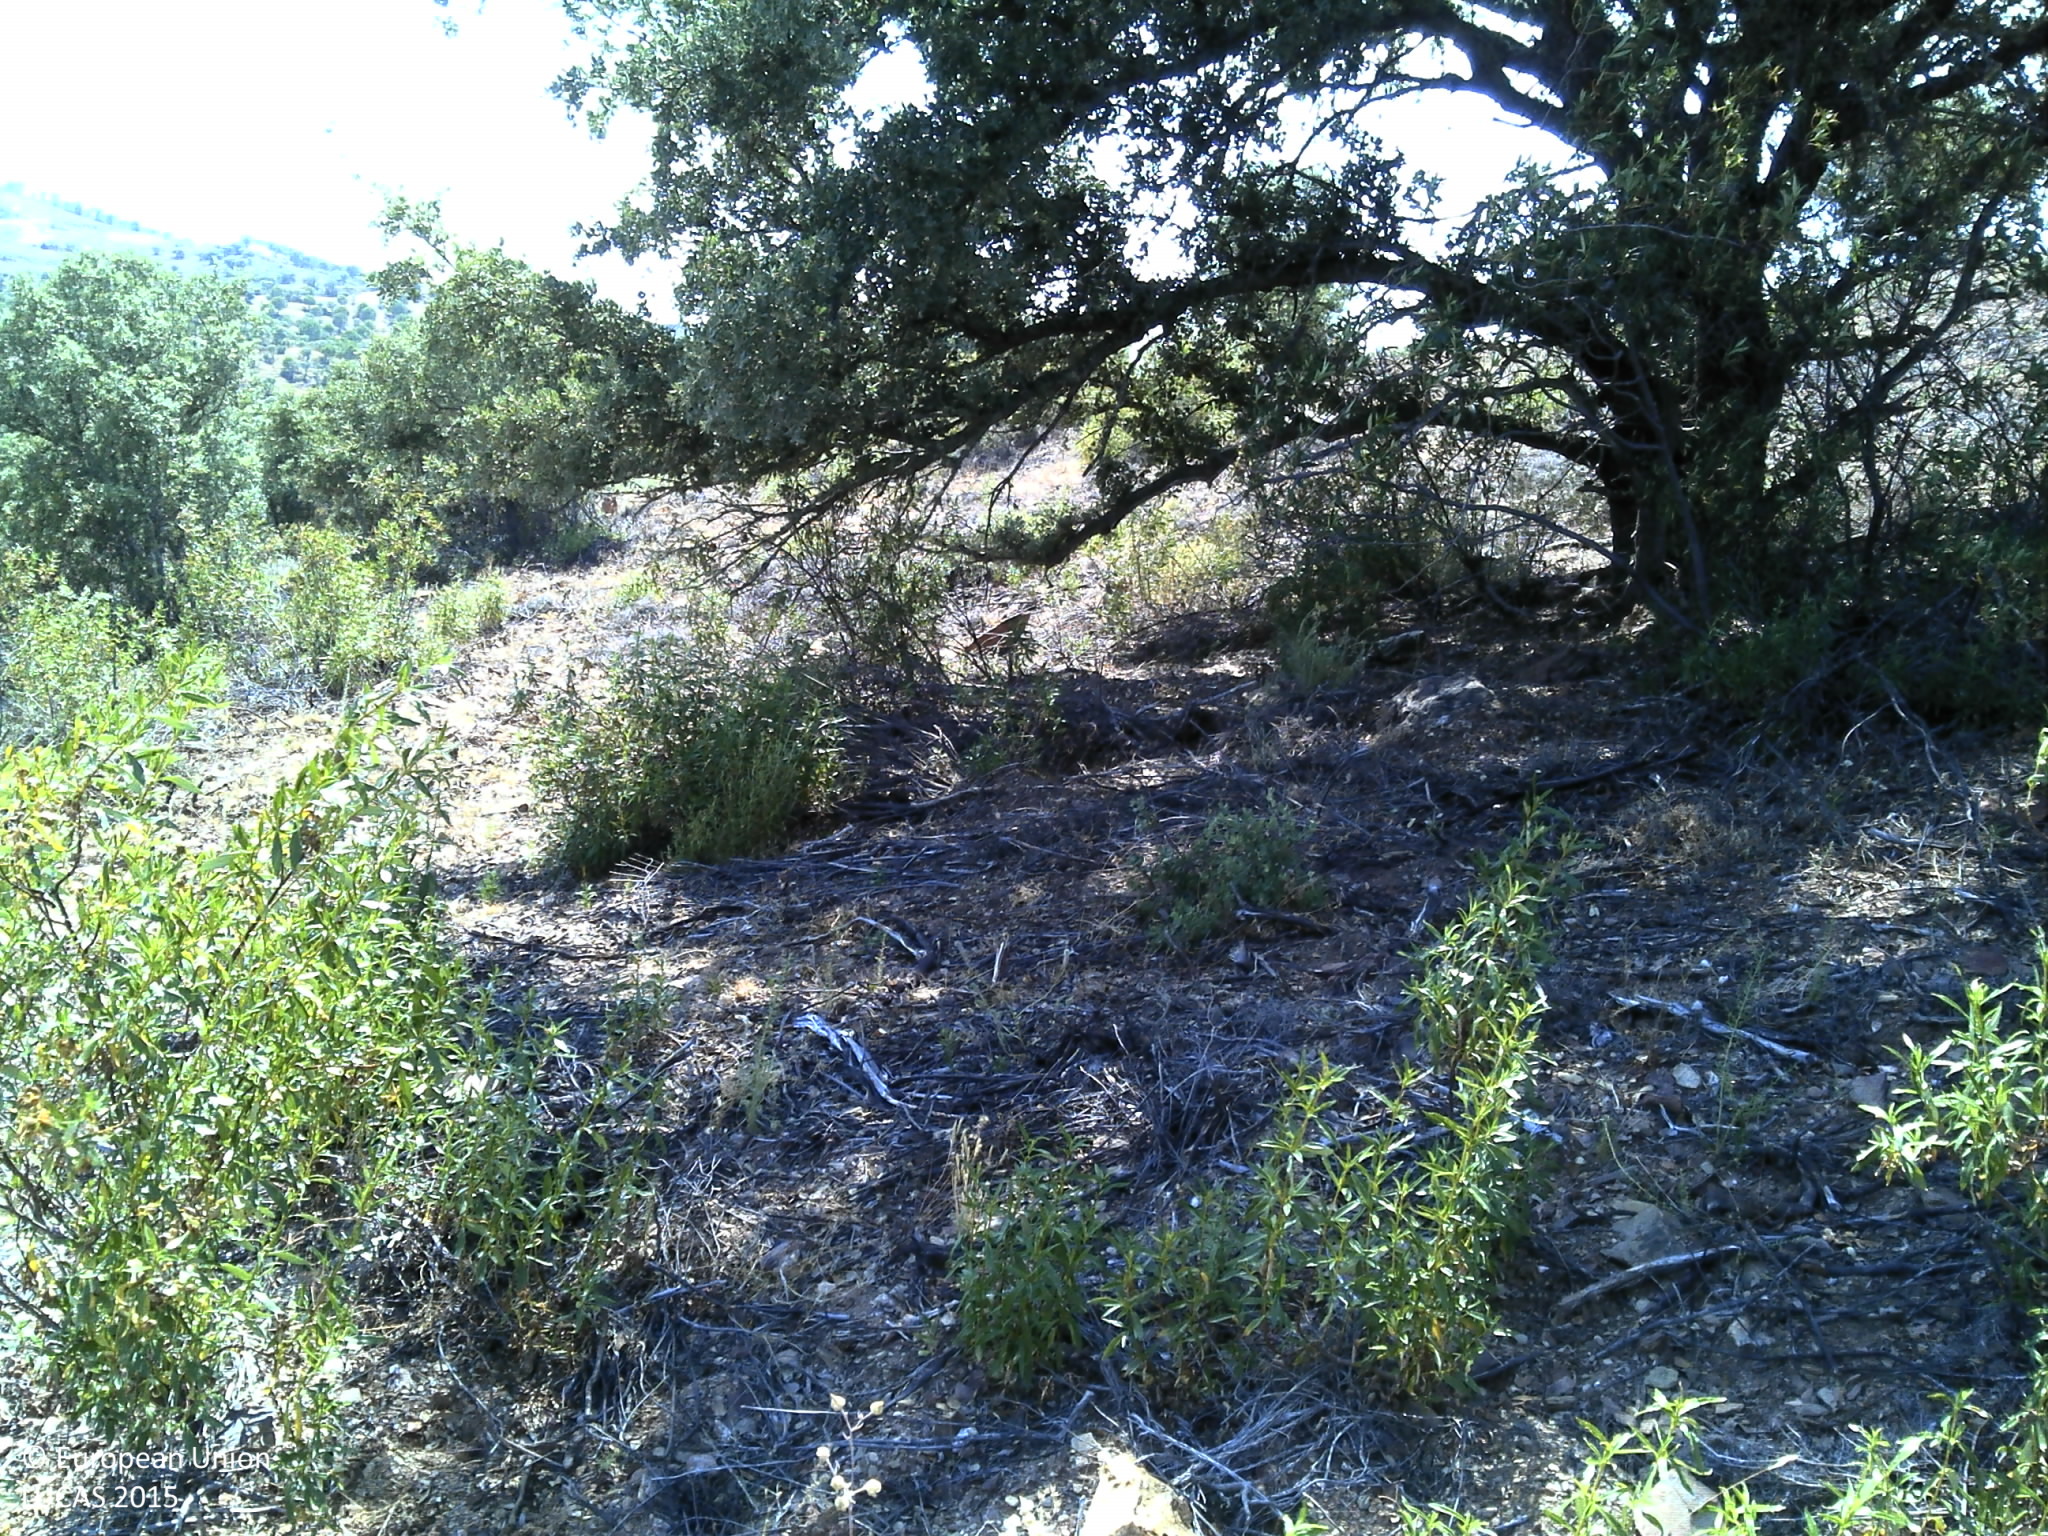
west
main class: Shrubland
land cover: Shrubland with sparse tree cover
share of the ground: 10 - 25 %
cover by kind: unconsolidated bare surface 60 %, shrubs 20 %, herbaceous plants 15 %, broadleaved forest trees 5 %
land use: Agriculture (excluding fallow land and kitchen gardens)
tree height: > 5 m
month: June
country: PT
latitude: 37.6501
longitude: -7.4779
